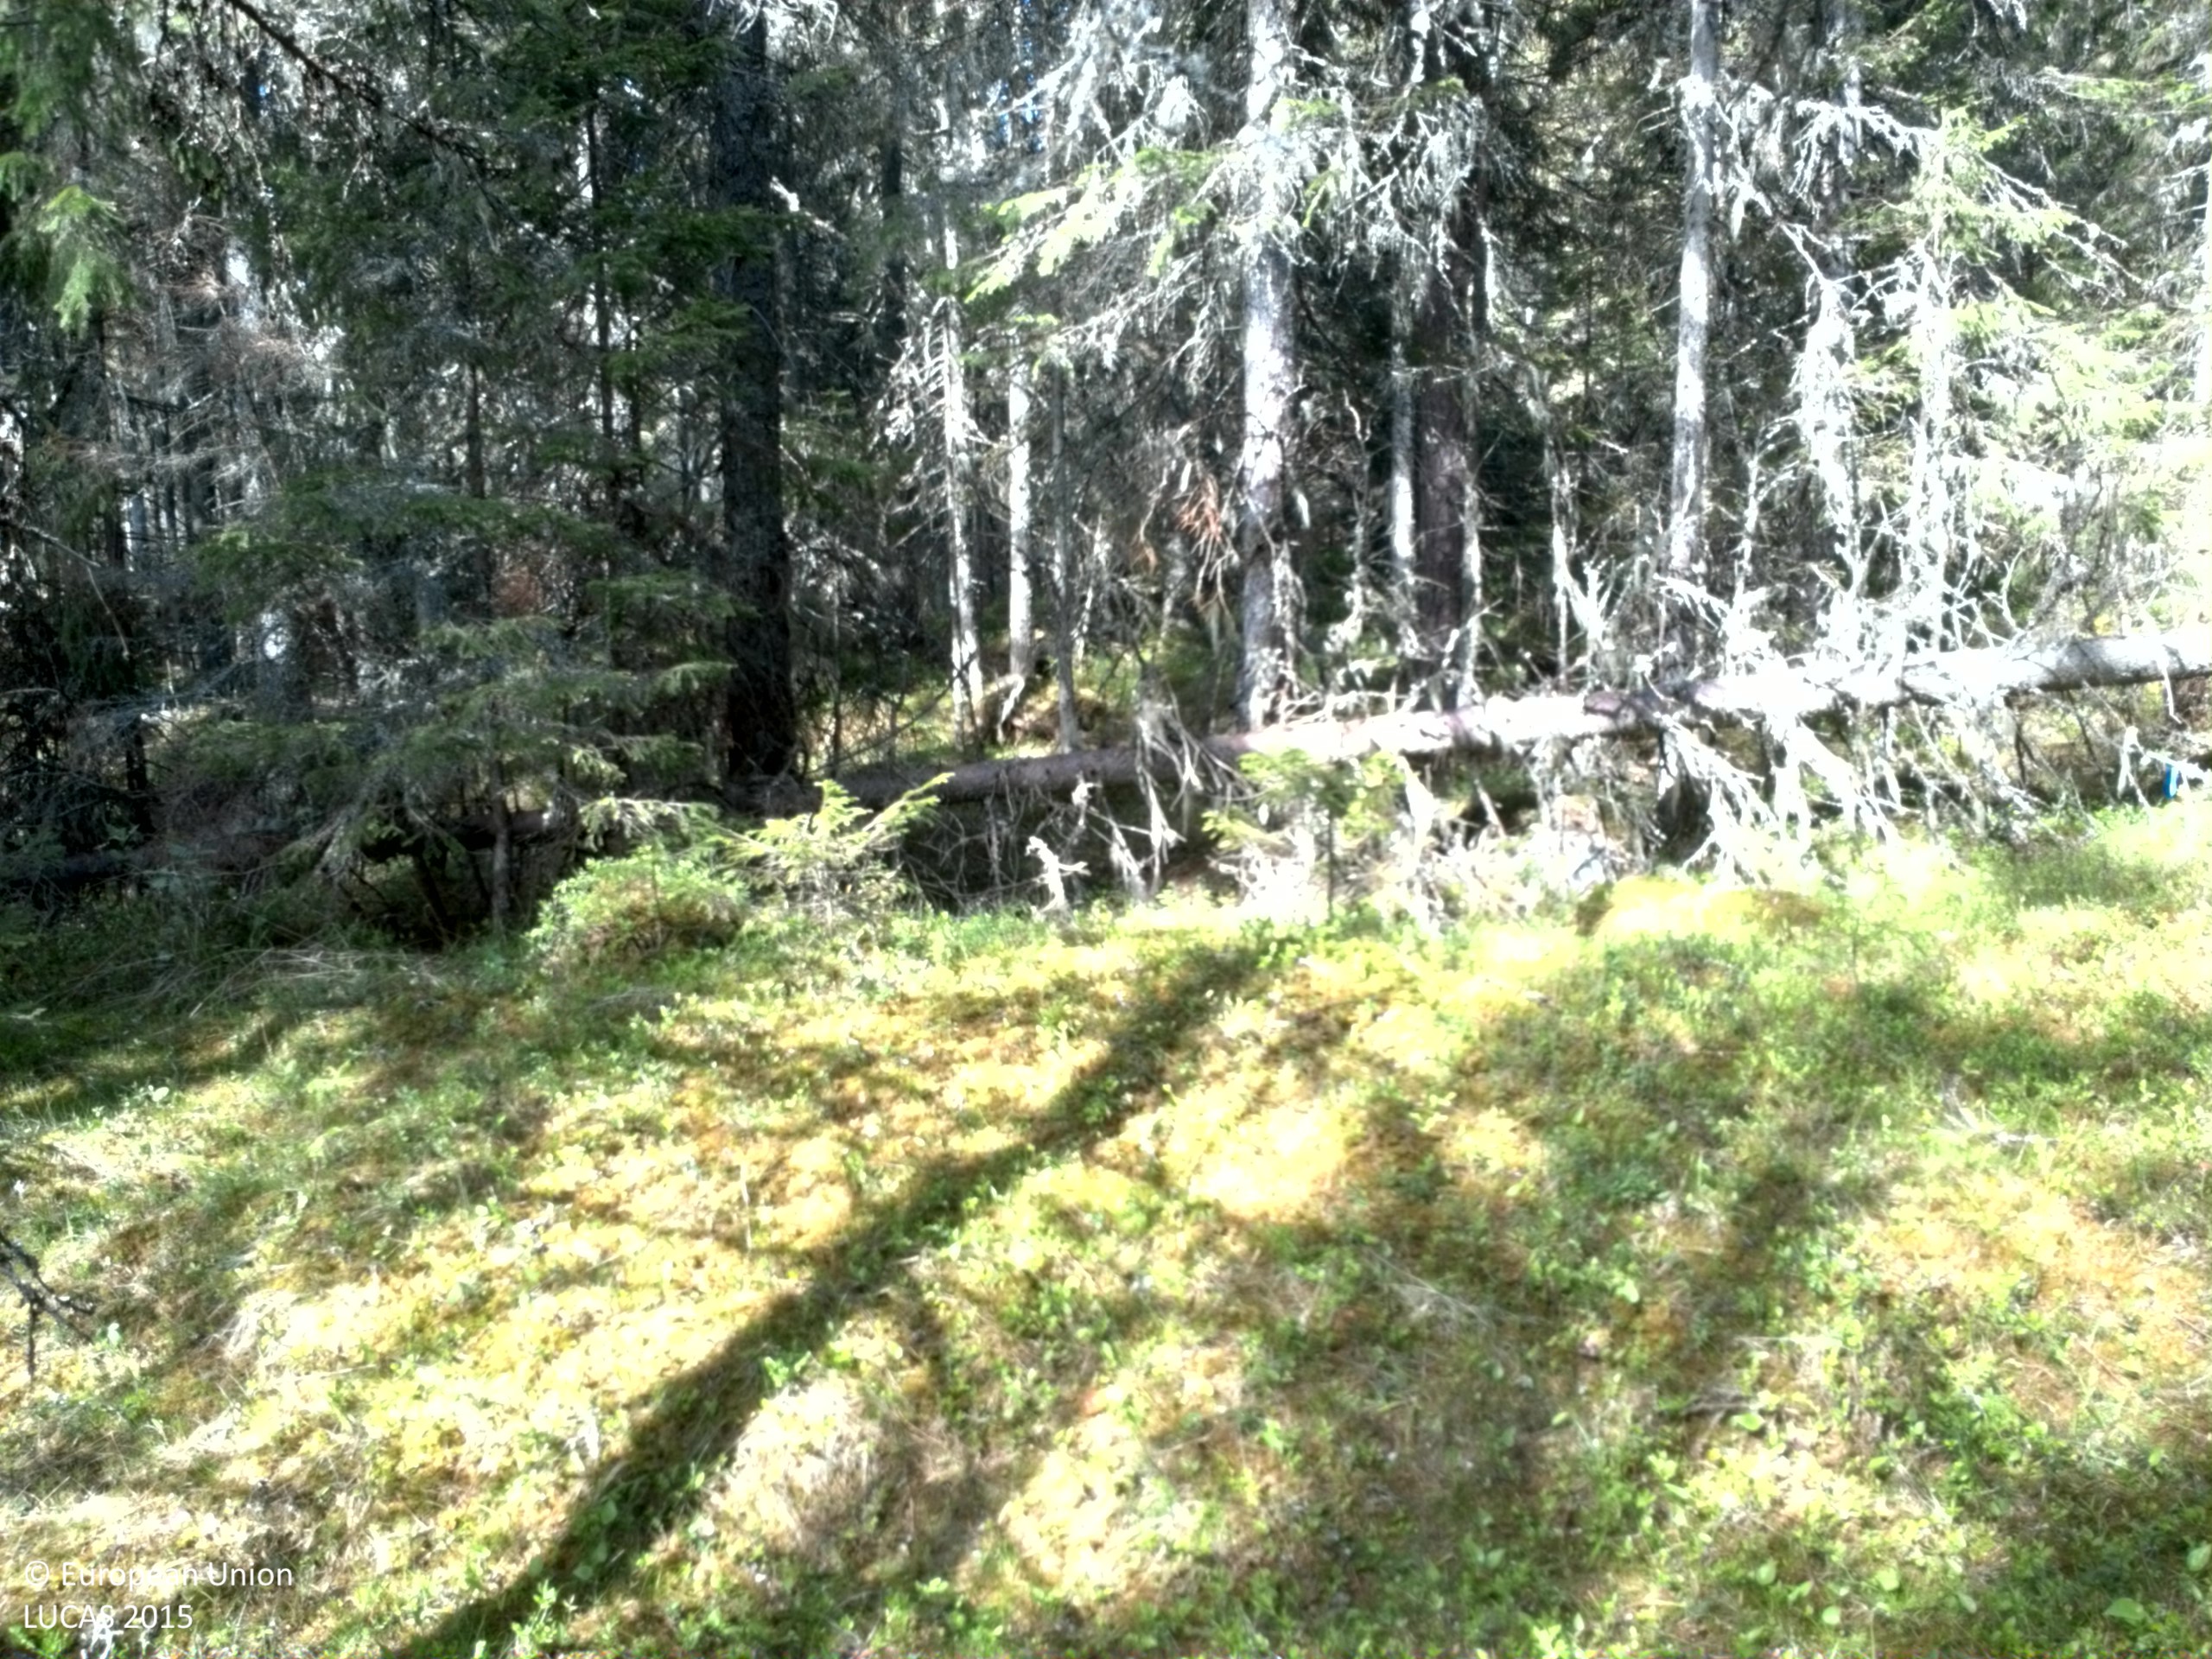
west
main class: Woodland
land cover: Spruce dominated coniferous woodland
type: boreal forest
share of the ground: > 75 %
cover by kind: coniferous forest trees 85 %, shrubs 15 %
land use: Forestry
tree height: > 5 m
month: May
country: SE
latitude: 62.8219
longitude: 18.2417
